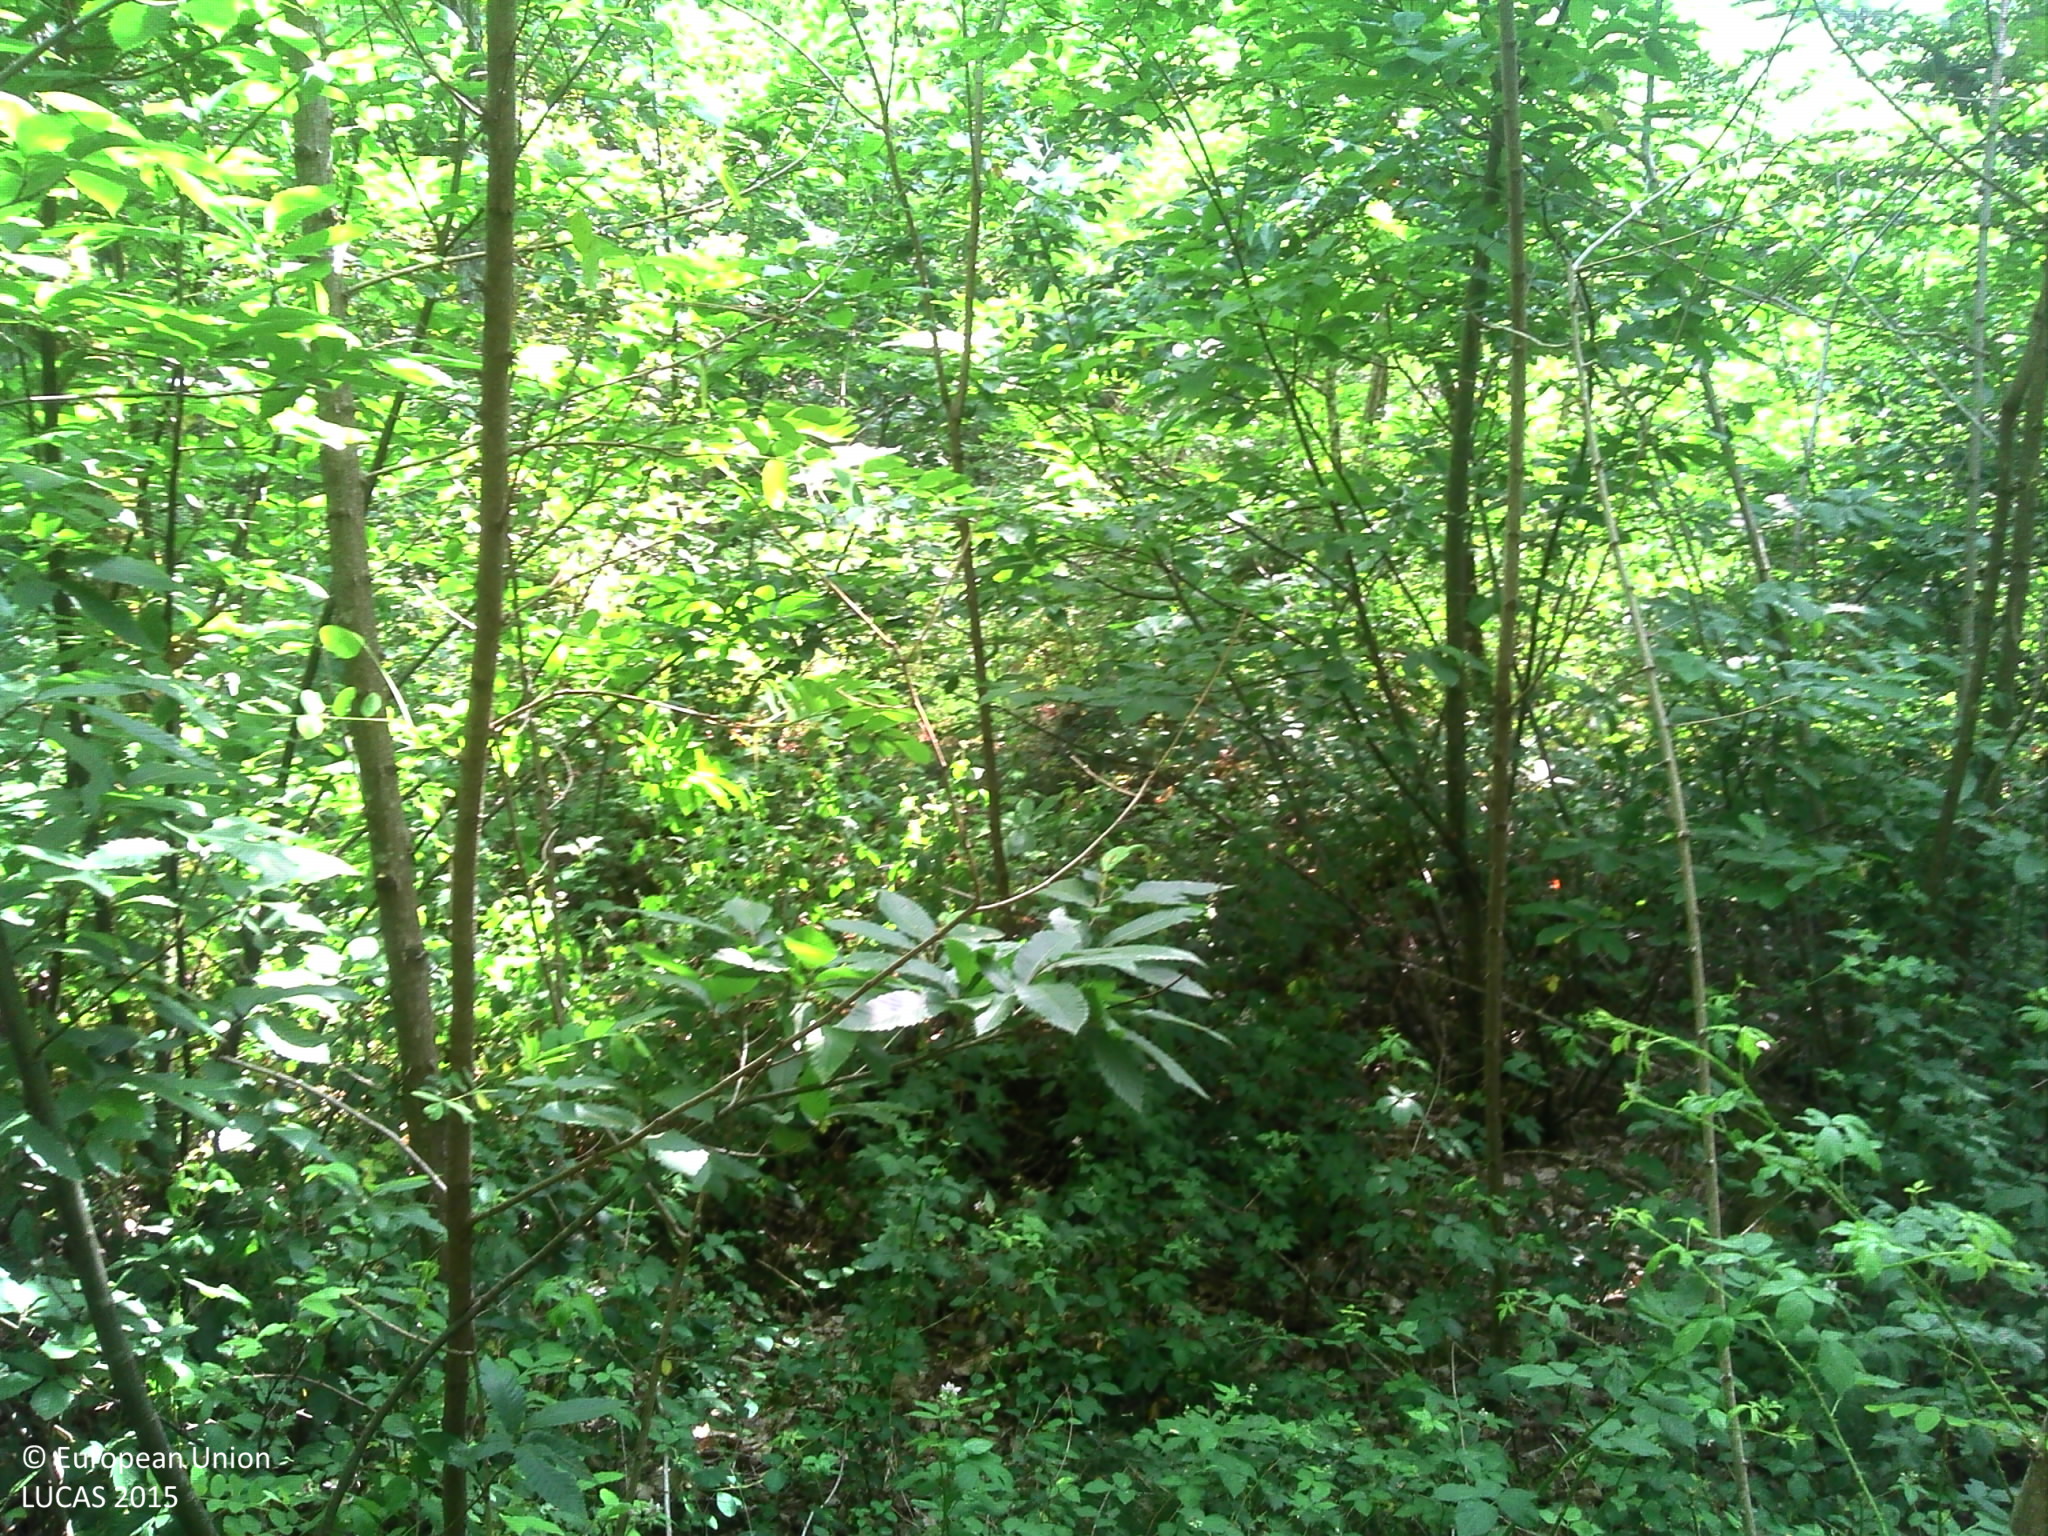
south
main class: Woodland
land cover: Broadleaved woodland
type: mesophytic deciduous forest
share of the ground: > 75 %
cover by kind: herbaceous plants 50 %, broadleaved forest trees 30 %, lichens and mosses 20 %
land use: Forestry
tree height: > 5 m
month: June
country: FR
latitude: 47.6264
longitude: 2.0180
